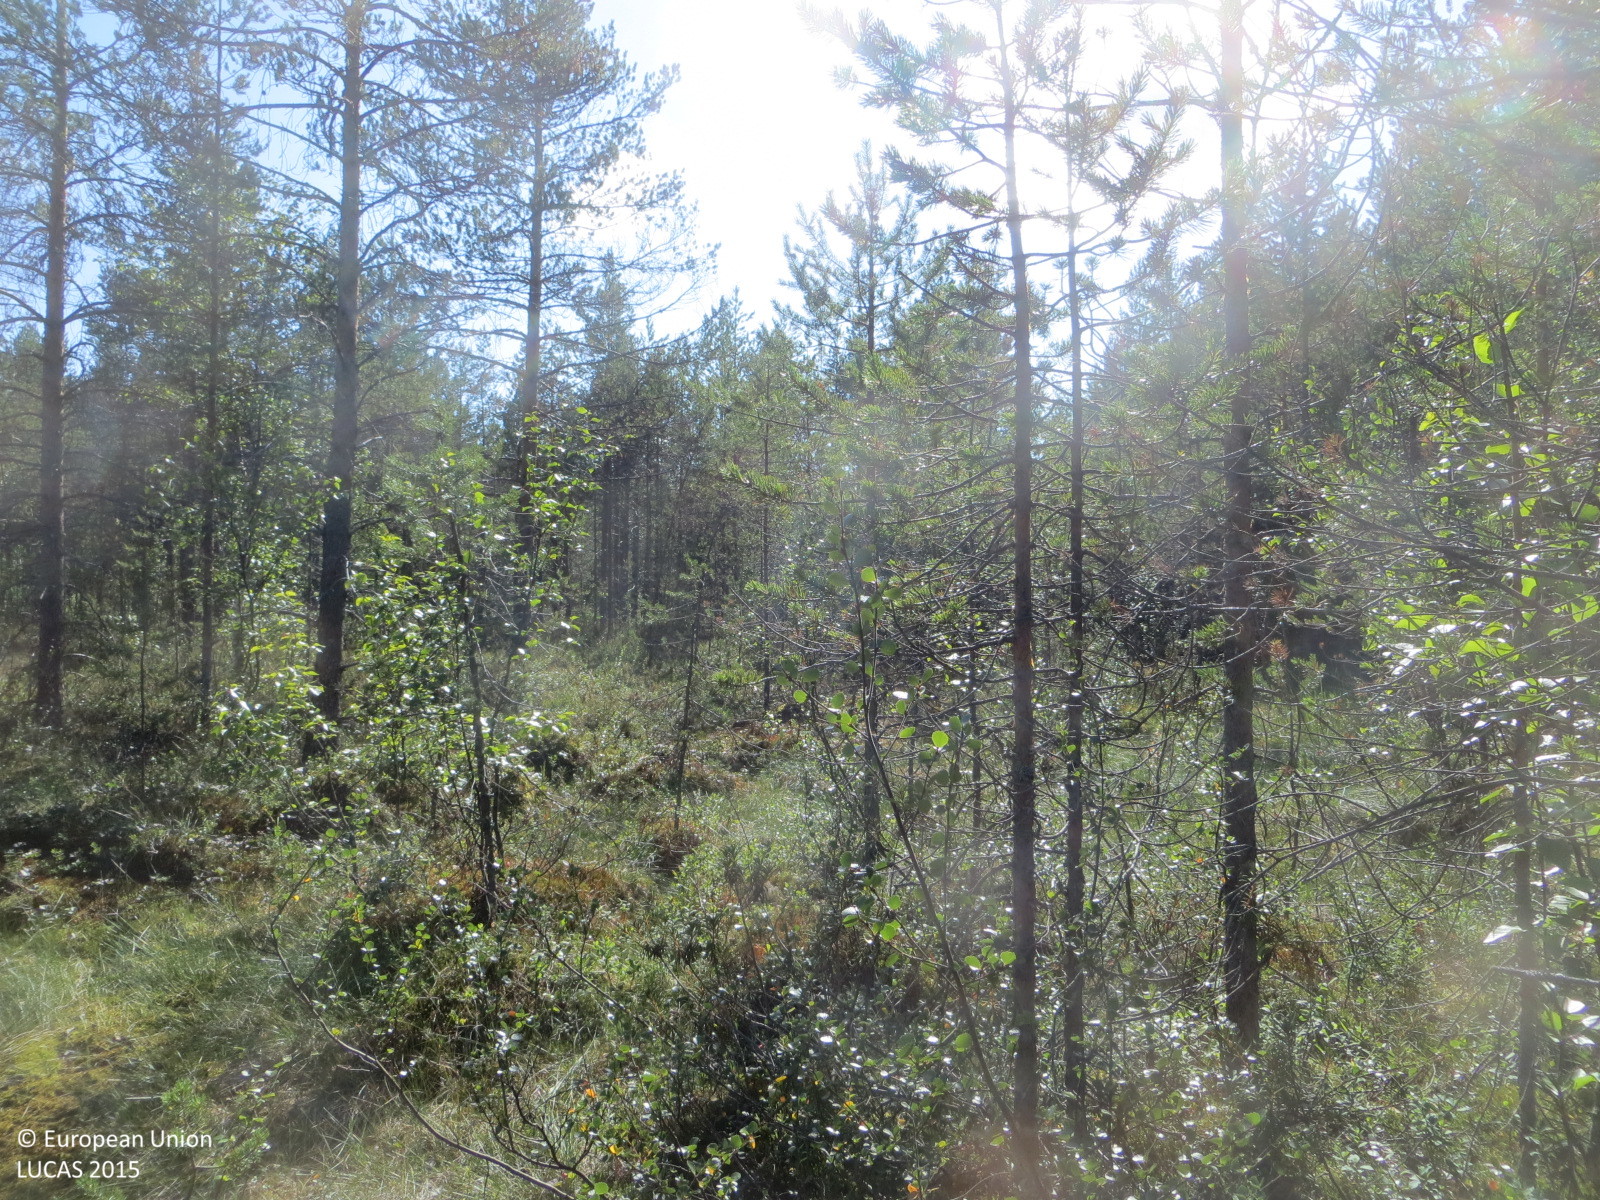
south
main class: Woodland
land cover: Pine dominated mixed woodland
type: mire and swamp forests
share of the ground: 50 - 75 %
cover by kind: coniferous forest trees 40 %, shrubs 40 %, broadleaved forest trees 20 %
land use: Forestry
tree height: > 5 m
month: July
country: FI
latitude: 66.0564
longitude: 24.0202
